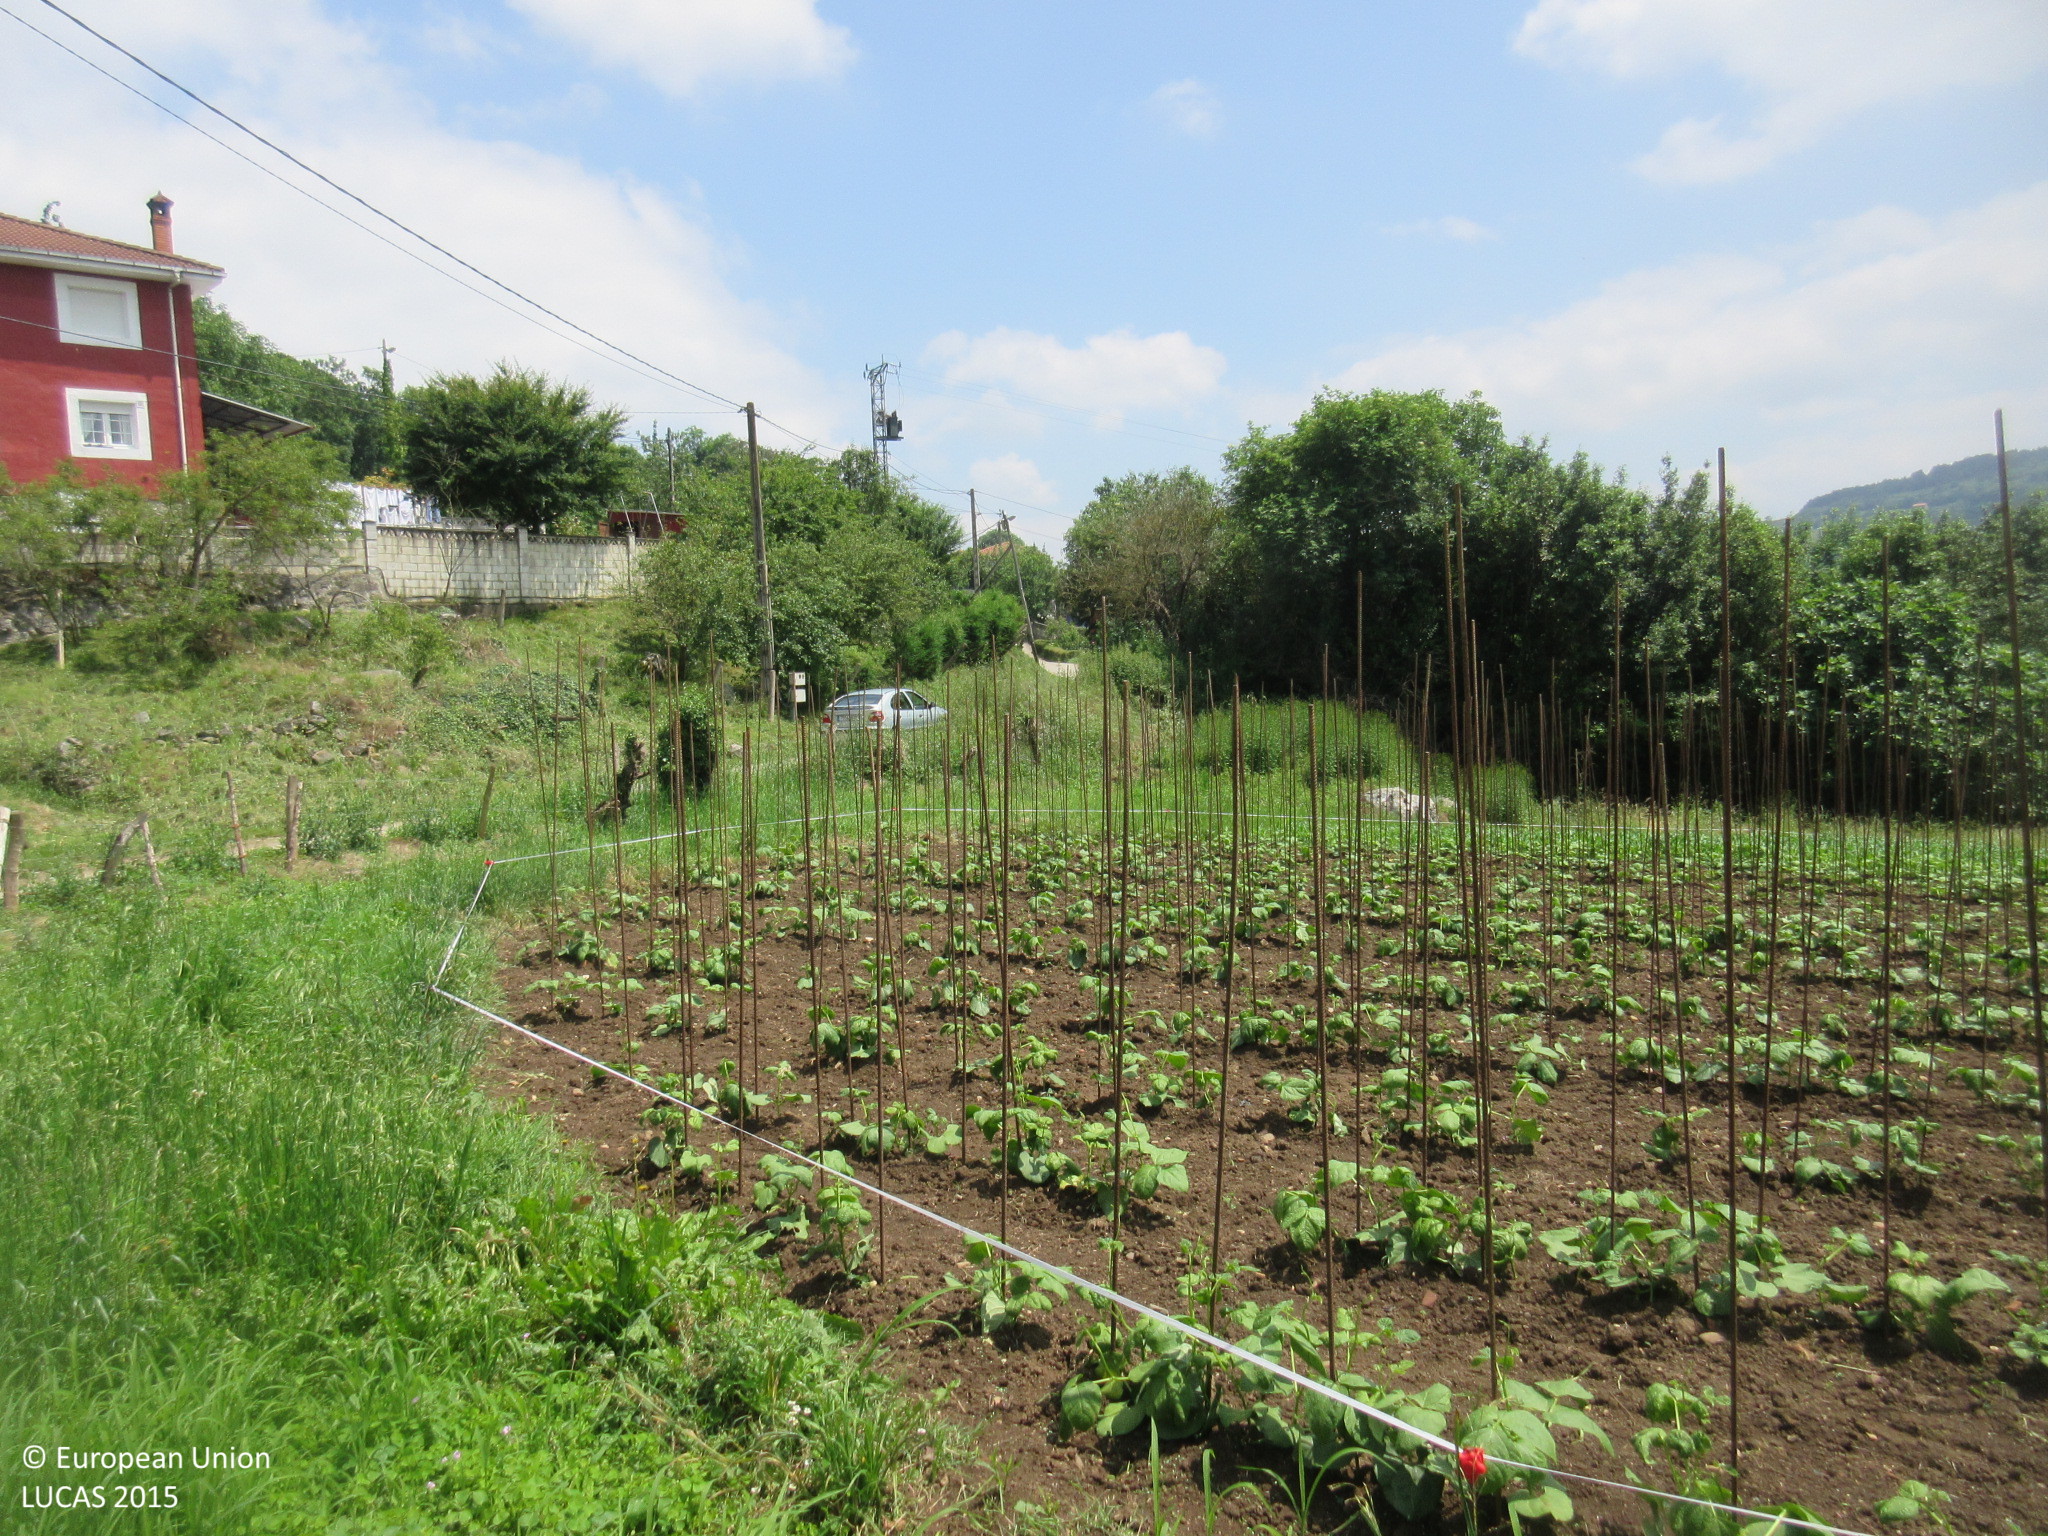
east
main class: Cropland
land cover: Dry pulses
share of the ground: 50 - 75 %
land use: Agriculture (excluding fallow land and kitchen gardens)
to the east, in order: Tracks; Dry pulses; Maize; Grass margins; Groves; Grassland without tree/shrub cover; Electric lines; Grassland without tree/shrub cover; Groves; Tracks; Dry stone walls; Grassland without tree/shrub cover; Dry stone walls; Artificial constructions in urban areas; Apple fruit; Groves; Dry stone walls; Abandoned hedges; Grassland without tree/shrub cover
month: June
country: ES
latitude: 43.3533
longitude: -6.0194
